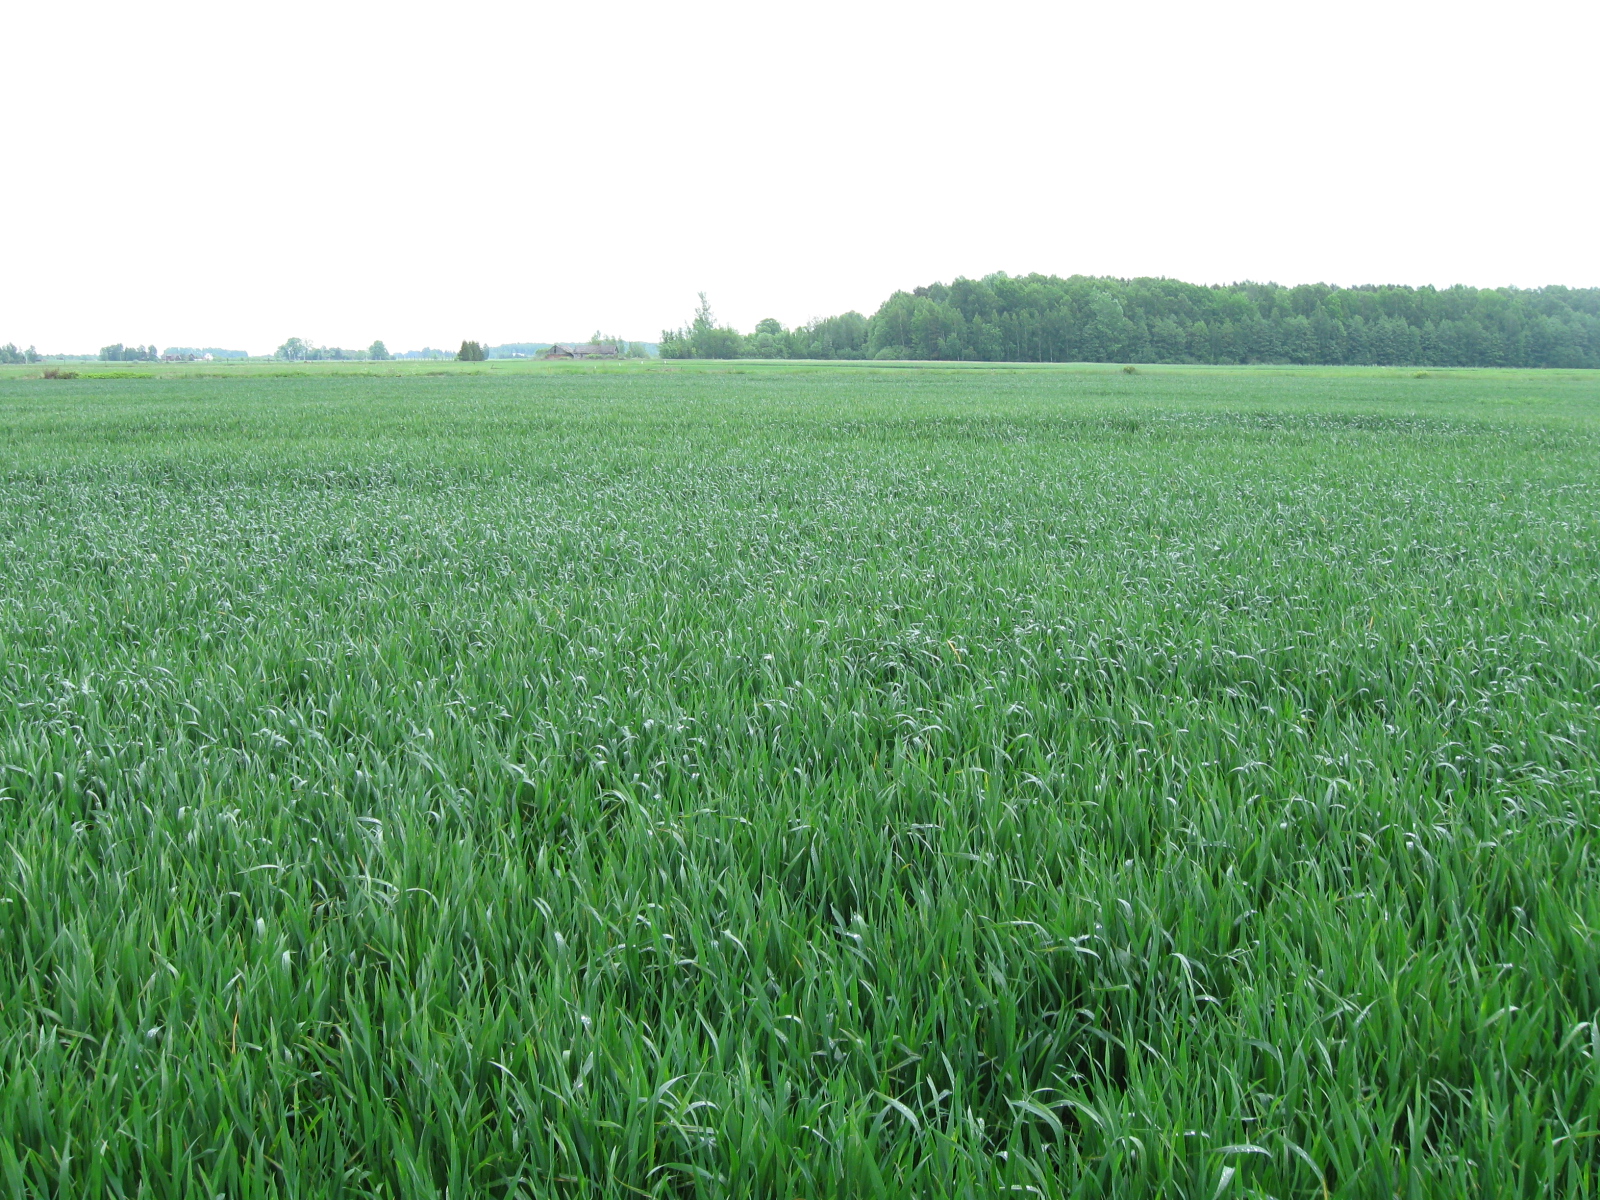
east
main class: Cropland
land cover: Common wheat
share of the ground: > 75 %
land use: Agriculture (excluding fallow land and kitchen gardens)
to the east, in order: Common wheat; Grass margins; Paved roads, cycling and walking lanes; Shruby margins; Ditches and canals; Grassland without tree/shrub cover; Barley
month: May
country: LT
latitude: 55.0278
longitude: 22.8495
